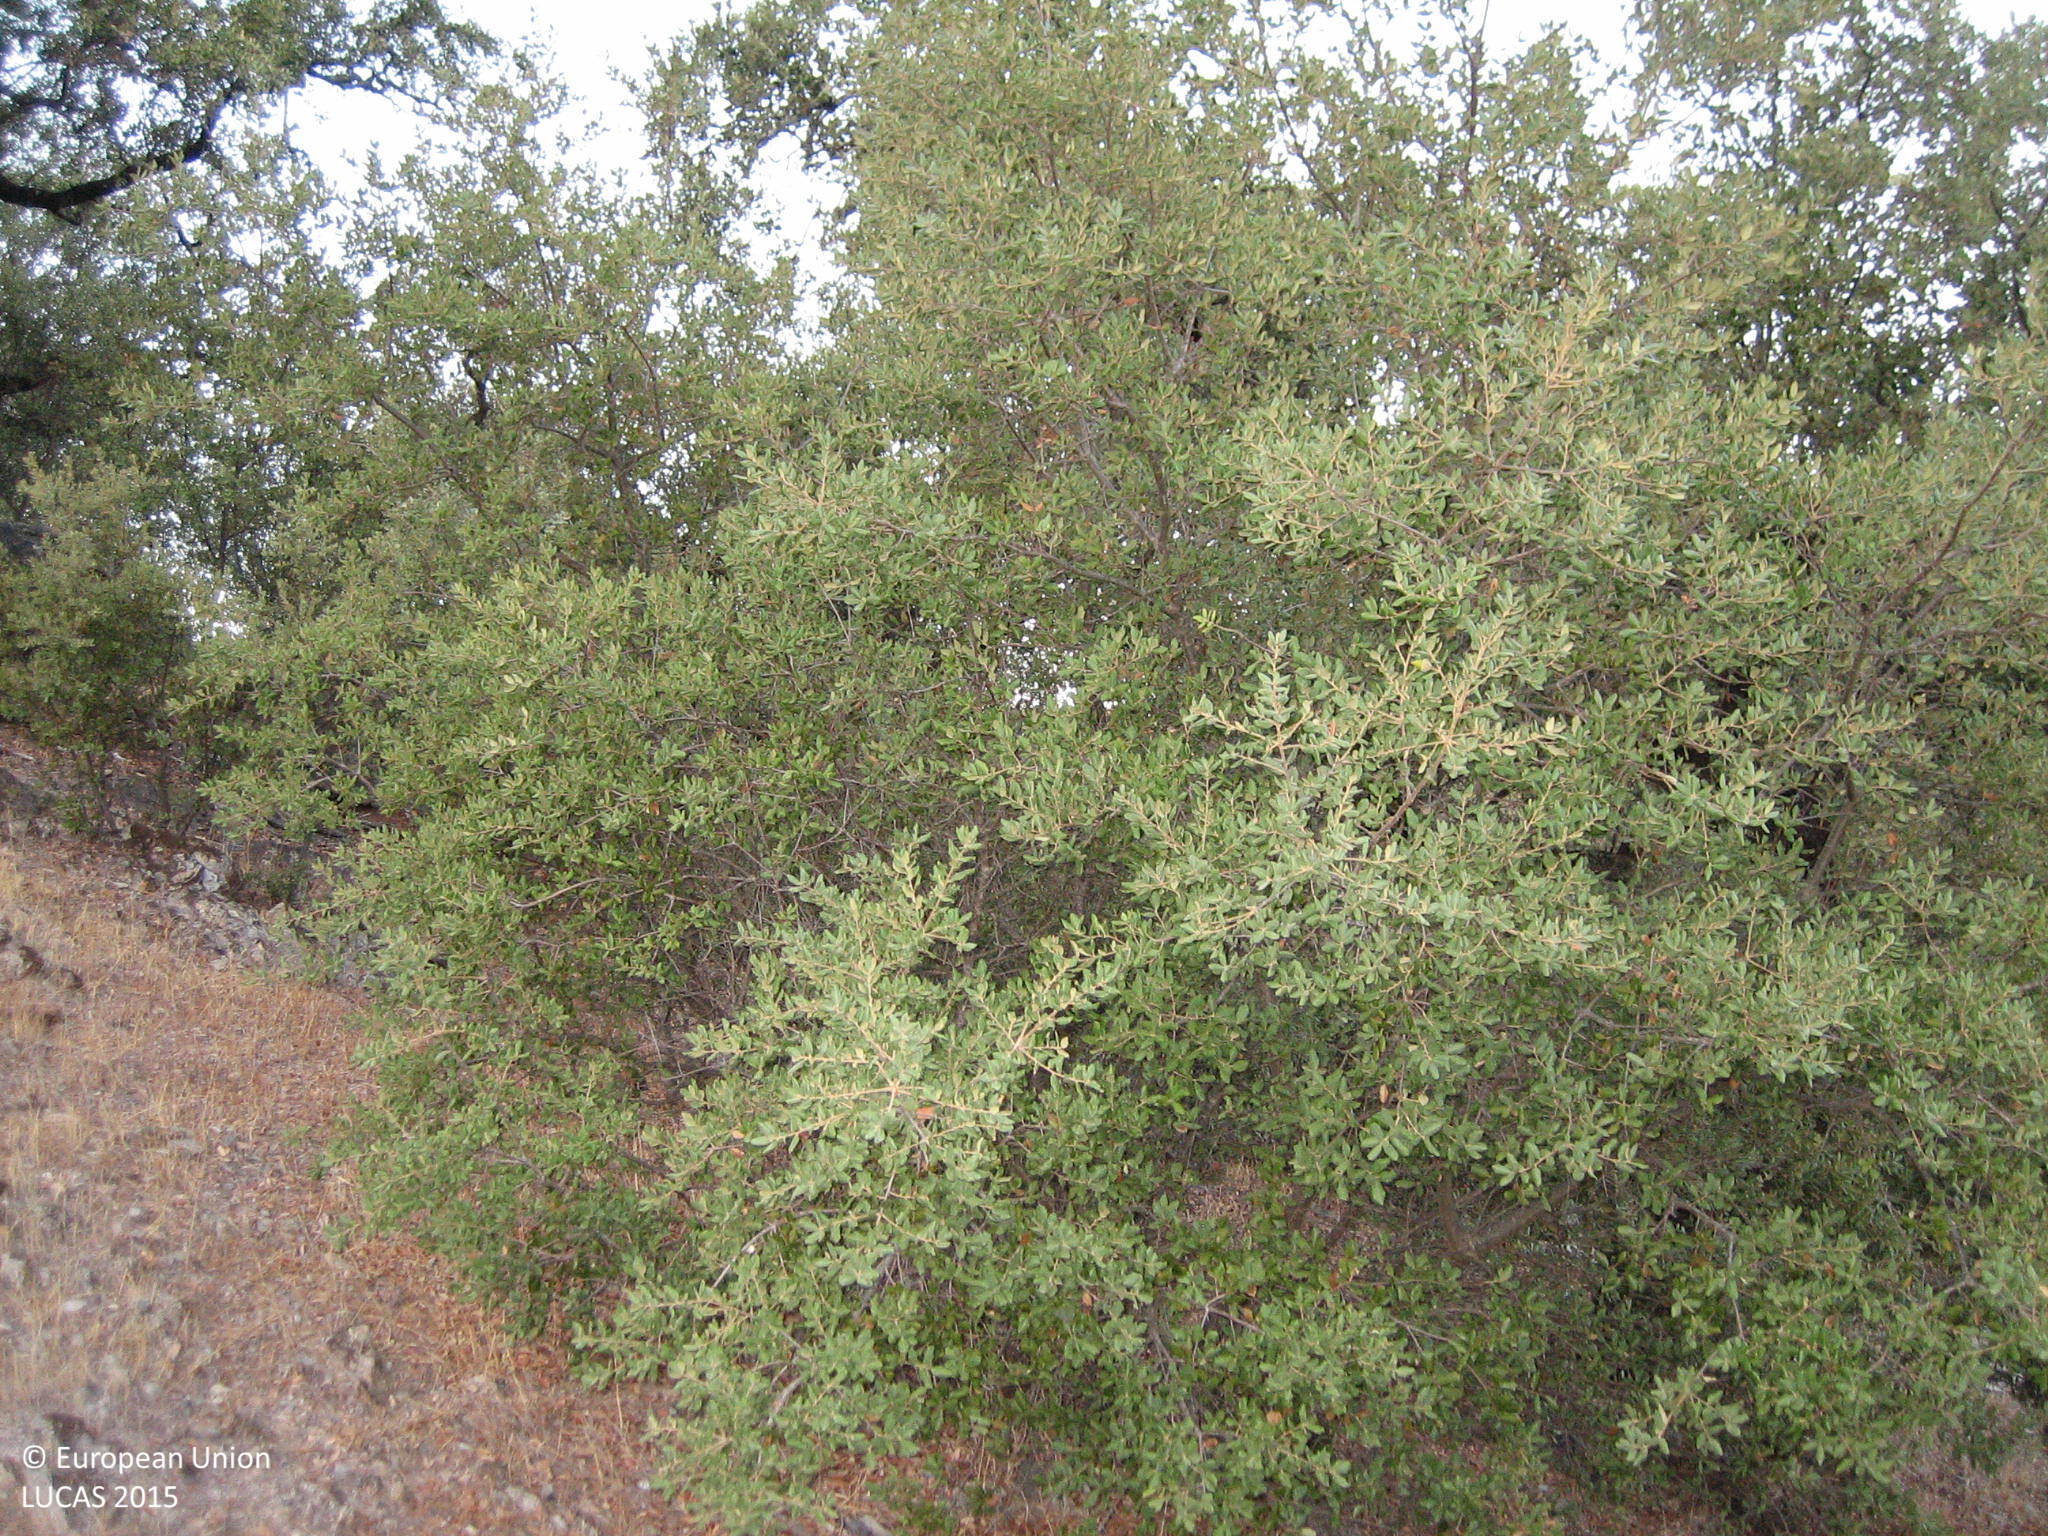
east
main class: Woodland
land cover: Broadleaved woodland
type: broadleaved evergreen forest
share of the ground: 10 - 25 %
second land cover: Shrubland without tree cover
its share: 10 - 25 %
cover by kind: herbaceous plants 40 %, broadleaved forest trees 20 %, shrubs 20 %, unconsolidated bare surface 20 %
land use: Forestry
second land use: Agriculture (excluding fallow land and kitchen gardens)
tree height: < 5 m
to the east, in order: Broadleaved woodland; Shrubland without tree cover
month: September
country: ES
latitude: 38.3610
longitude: -7.1271
